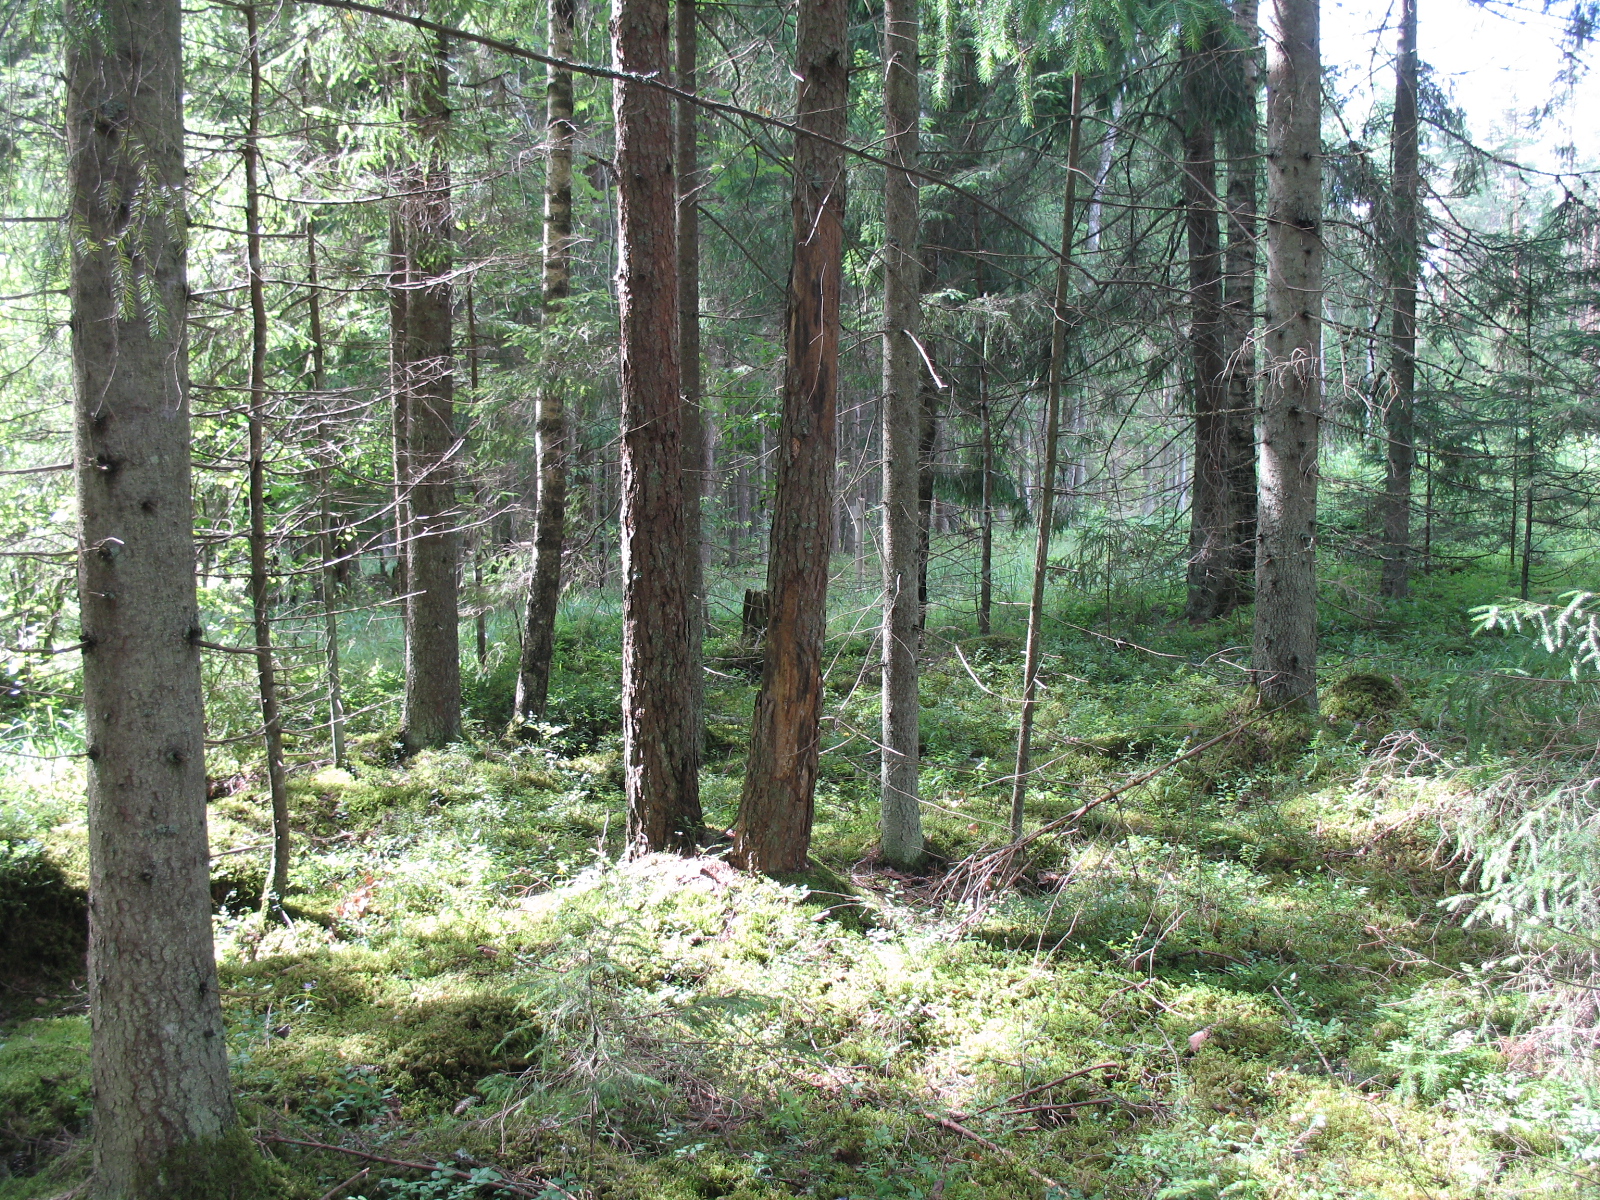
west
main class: Woodland
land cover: Other coniferous woodland
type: hemiboreal forest and nemoral coniferous forest and mixed broadleaved-coniferous forest
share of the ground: > 75 %
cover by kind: coniferous forest trees 85 %, lichens and mosses 10 %, herbaceous plants 5 %
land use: Forestry
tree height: > 5 m
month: July
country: LV
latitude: 56.5451
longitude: 25.1561
